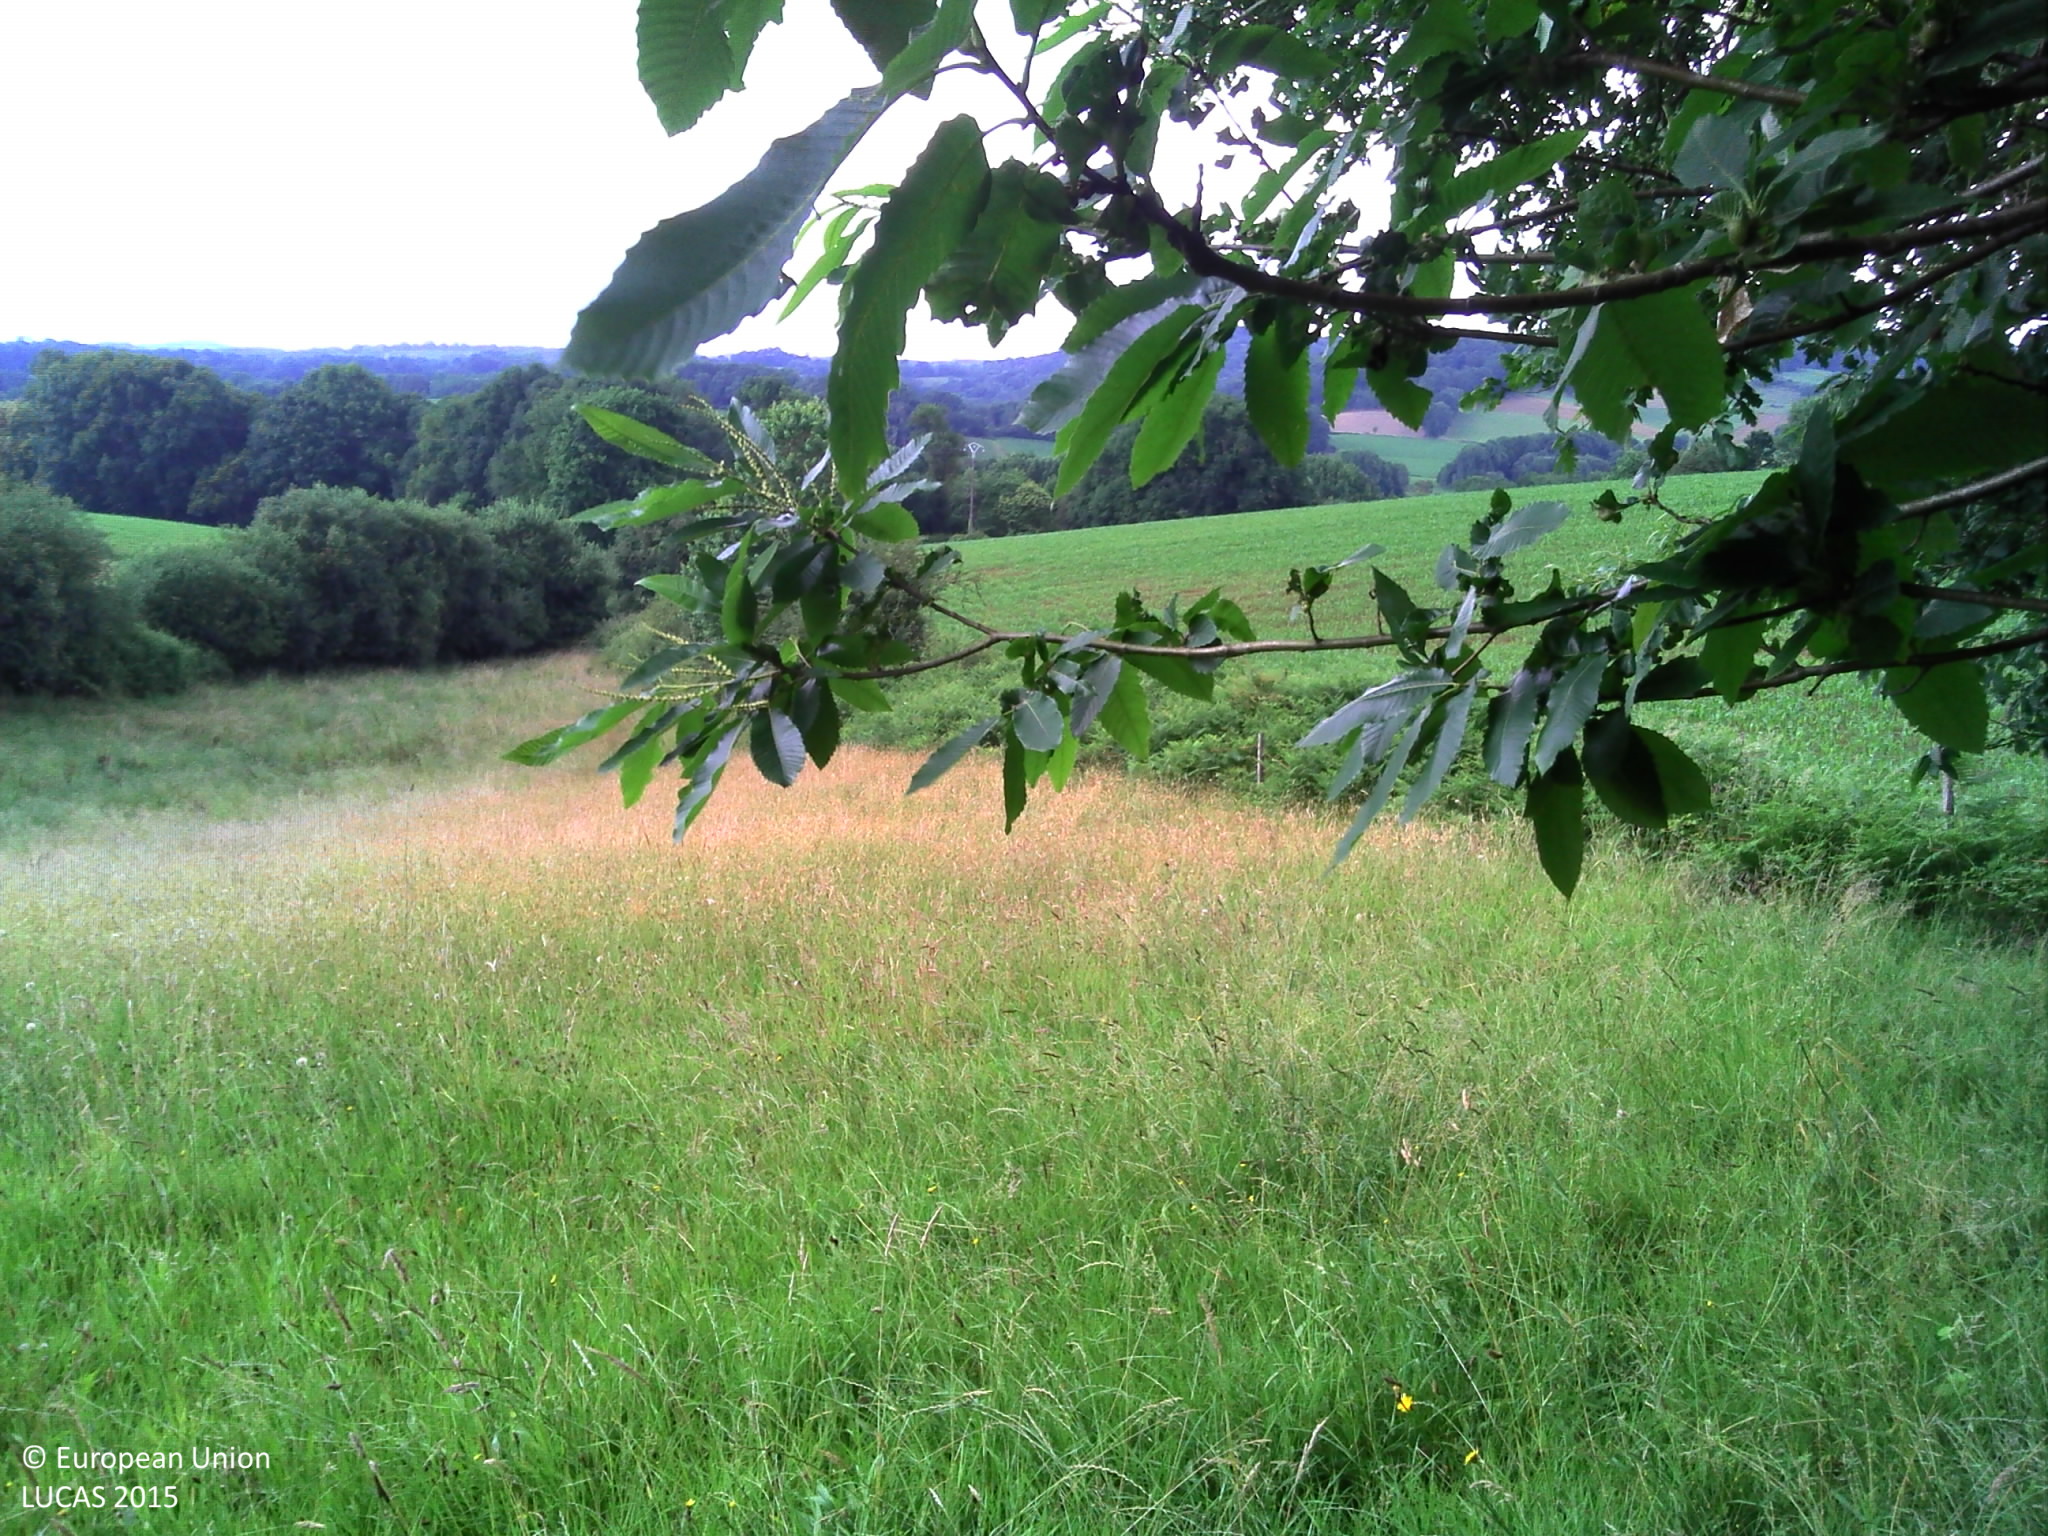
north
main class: Grassland
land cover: Grassland without tree/shrub cover
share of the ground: > 75 %
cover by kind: herbaceous plants 100 %
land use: Agriculture (excluding fallow land and kitchen gardens)
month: June
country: FR
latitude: 43.3024
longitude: -0.7222
